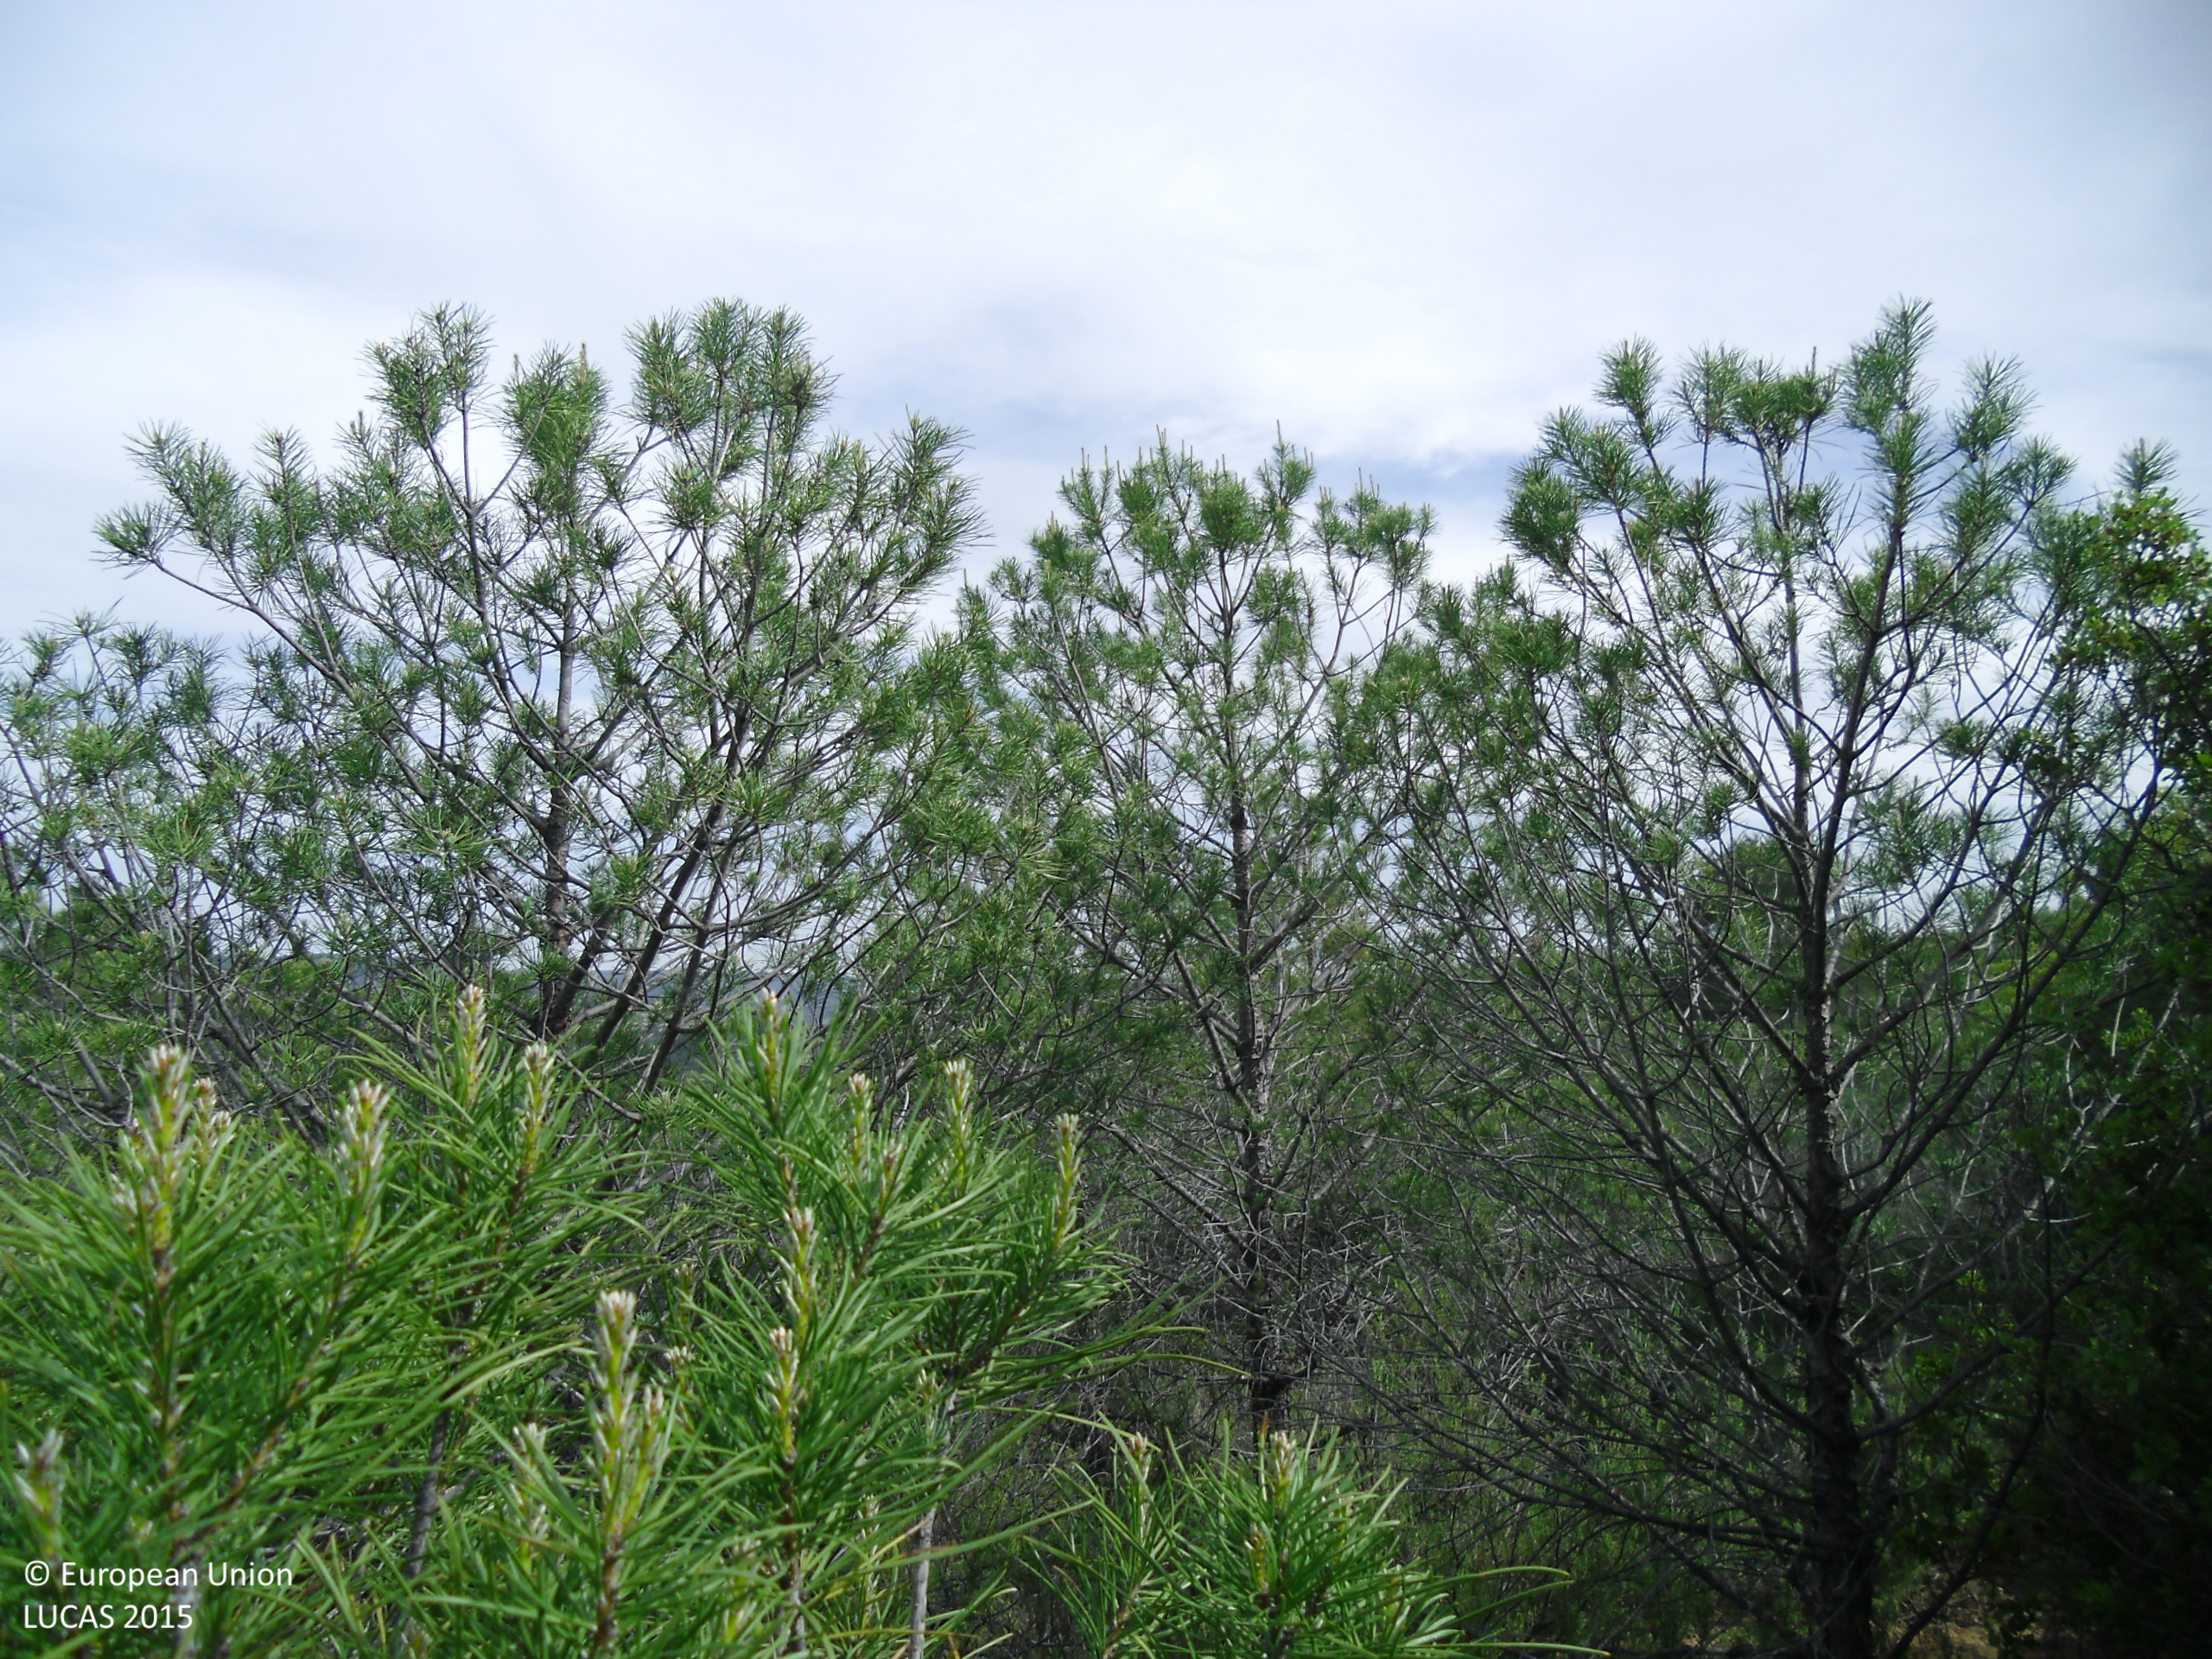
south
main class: Woodland
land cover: Pine dominated coniferous woodland
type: coniferous forest of the mediterranean region
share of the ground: > 75 %
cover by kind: coniferous forest trees 85 %, herbaceous plants 10 %, unconsolidated bare surface 5 %
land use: Forestry
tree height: > 5 m
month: May
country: ES
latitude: 40.3634
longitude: -2.8981
